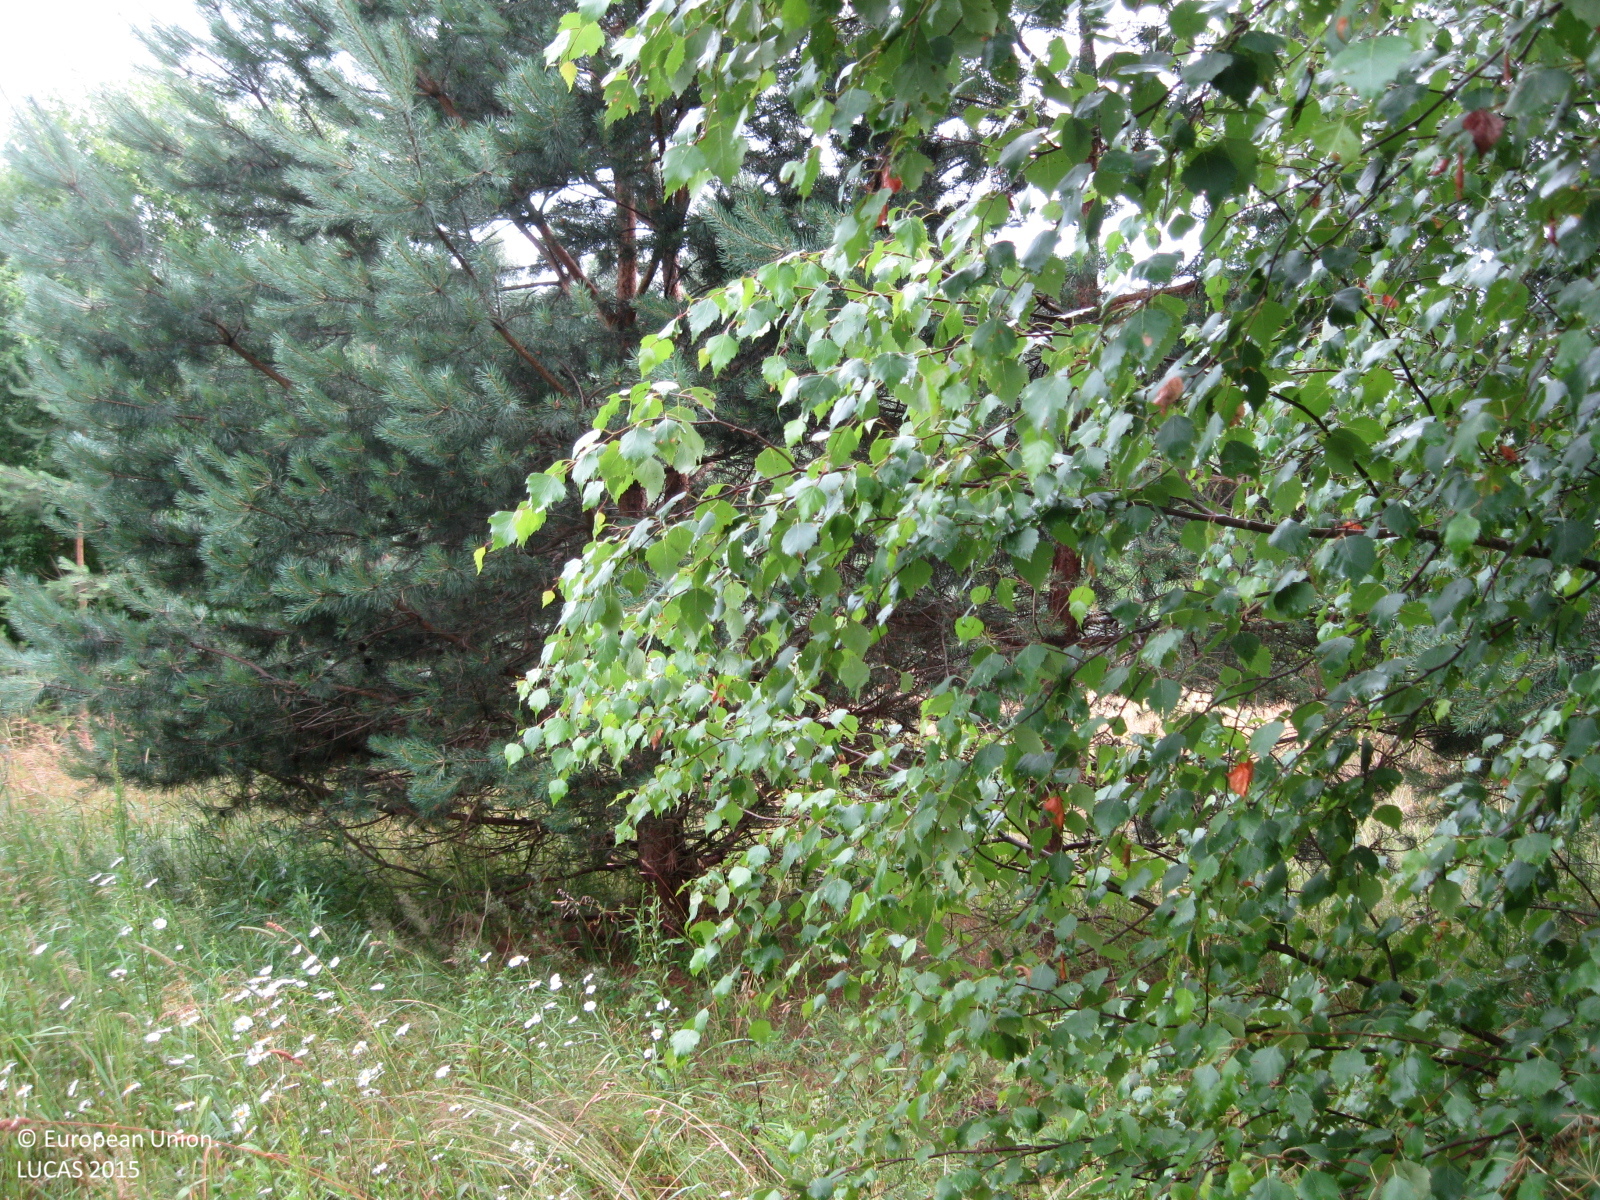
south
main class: Woodland
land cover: Pine dominated mixed woodland
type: hemiboreal forest and nemoral coniferous forest and mixed broadleaved-coniferous forest
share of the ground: 50 - 75 %
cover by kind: herbaceous plants 45 %, coniferous forest trees 35 %, broadleaved forest trees 20 %
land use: Forestry
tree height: > 5 m
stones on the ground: < 10 %
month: July
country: LT
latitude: 55.7503
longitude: 24.7463
